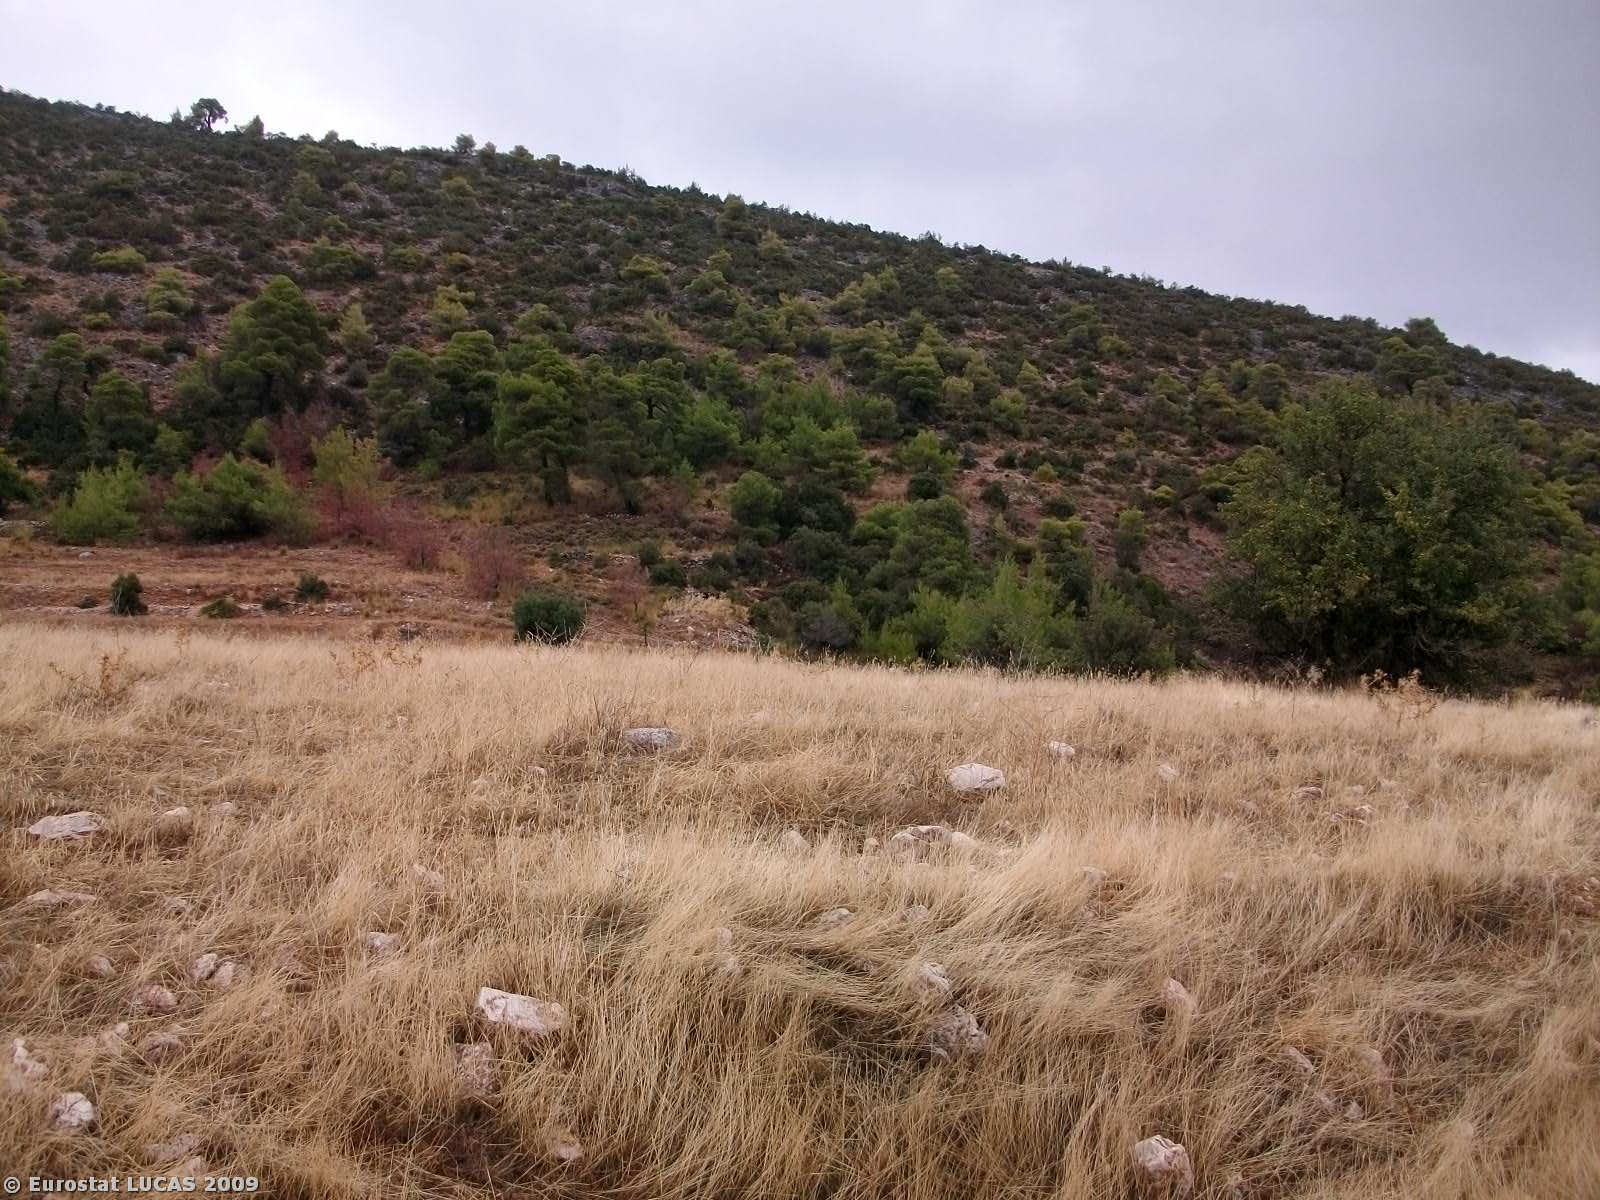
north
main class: Woodland
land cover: Coniferous woodland
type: coniferous forest of the mediterranean region
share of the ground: > 75 %
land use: Forestry
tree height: > 5 m
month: September
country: GR
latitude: 37.7902
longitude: 22.9726
